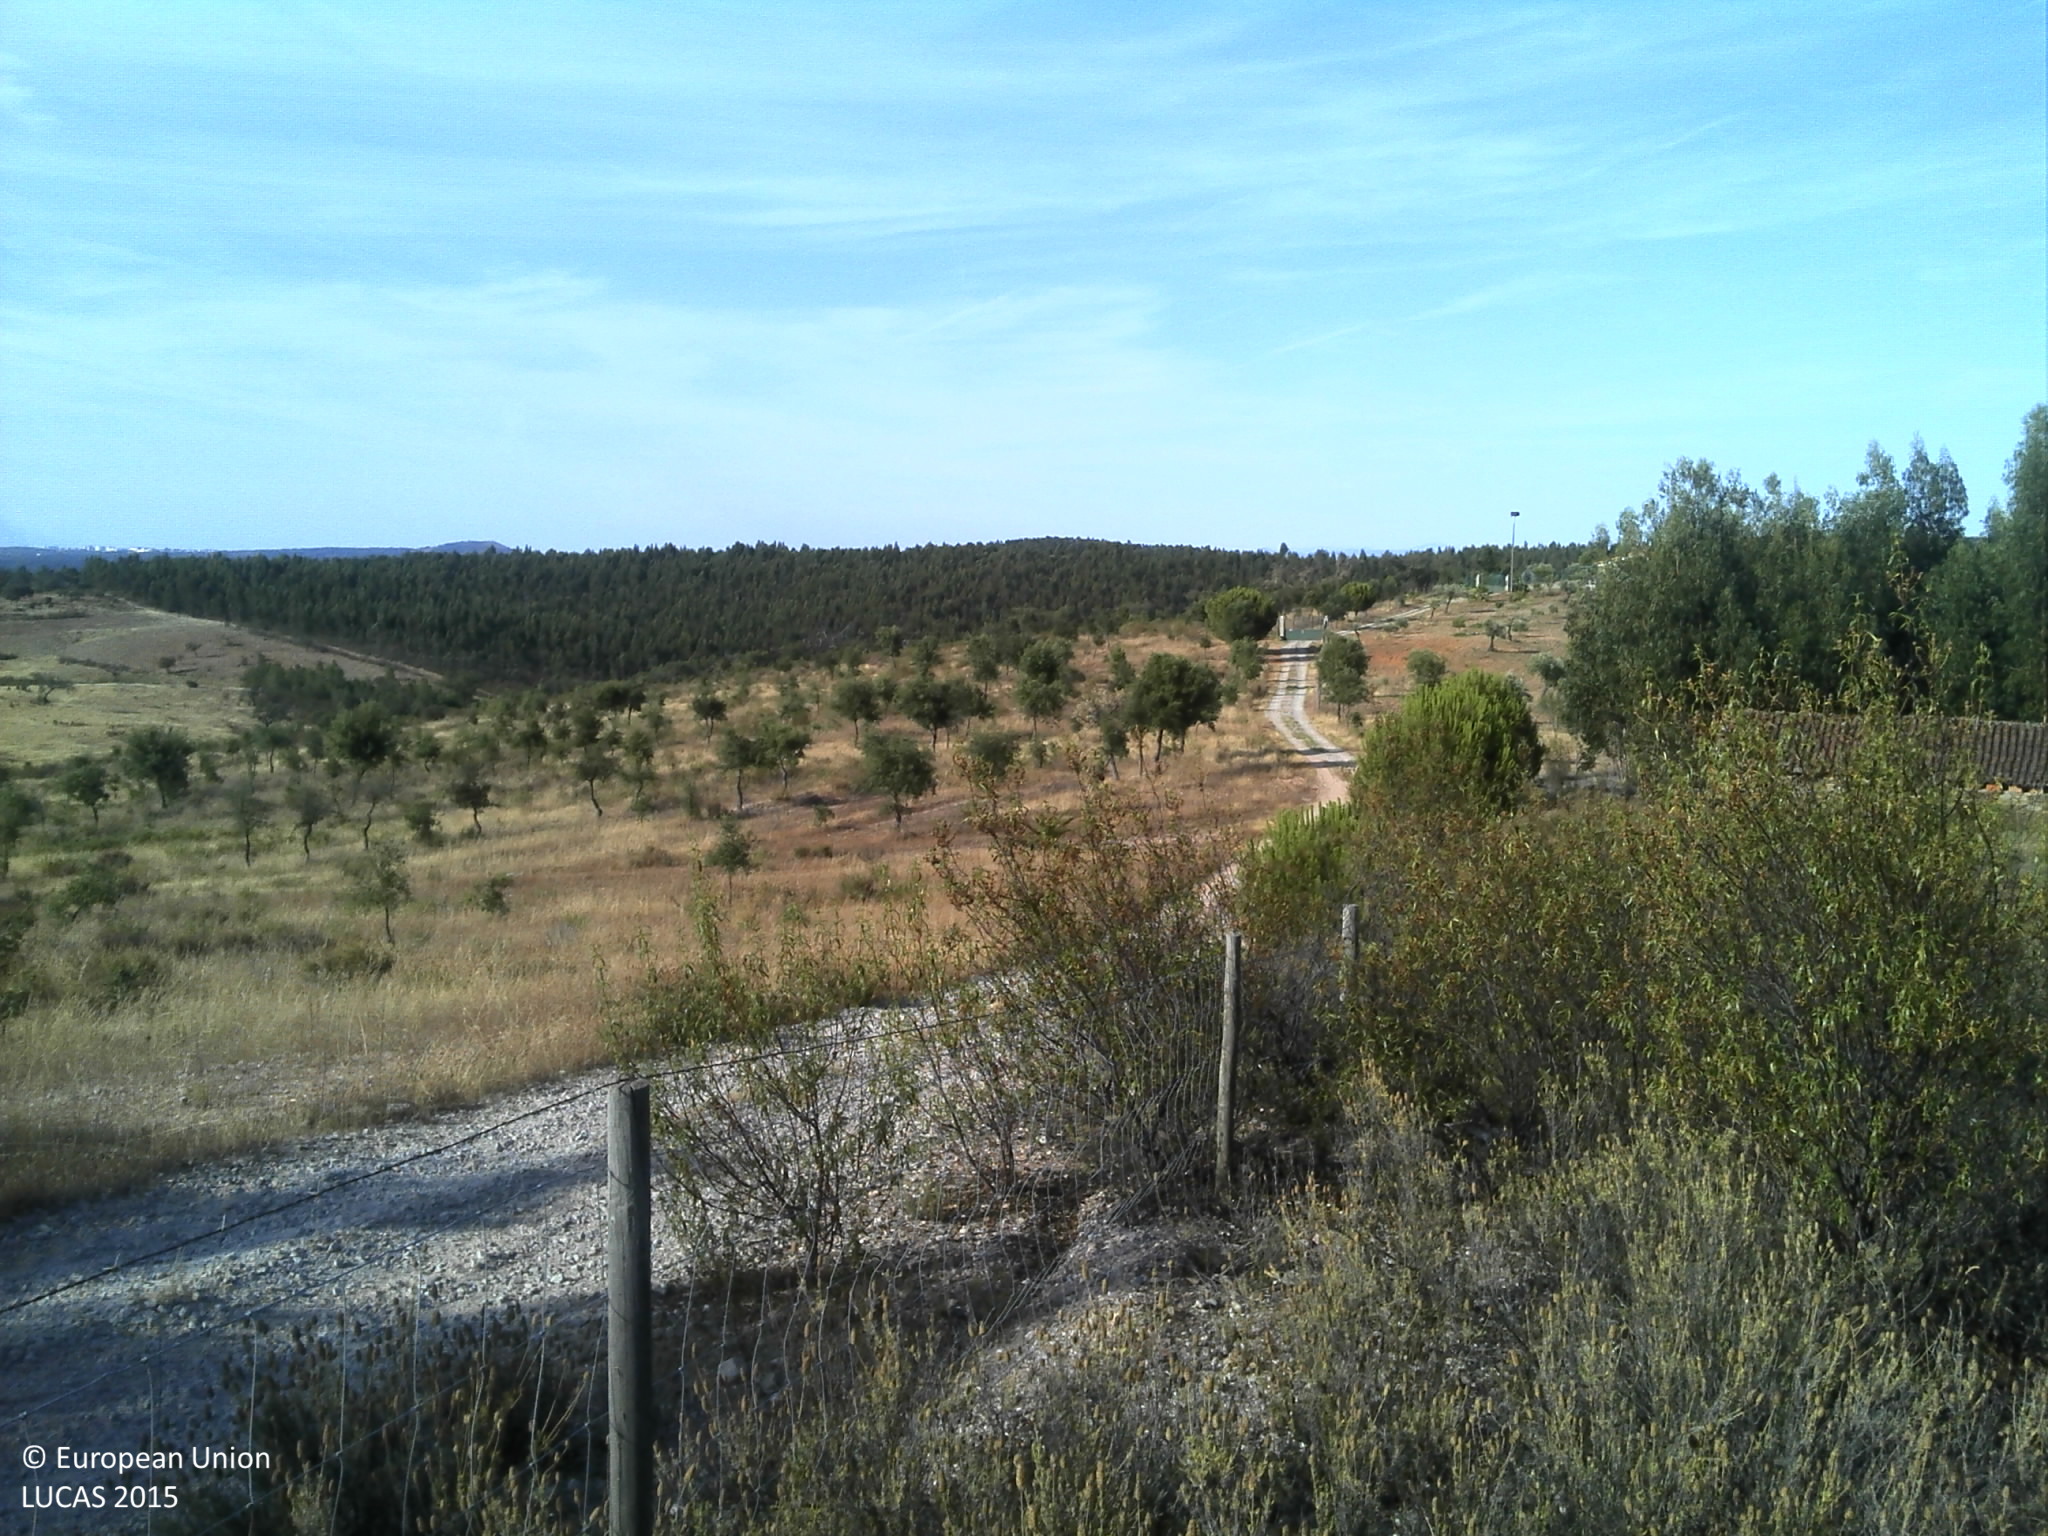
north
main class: Woodland
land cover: Broadleaved woodland
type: broadleaved evergreen forest
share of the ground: 10 - 25 %
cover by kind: unconsolidated bare surface 60 %, broadleaved forest trees 20 %, shrubs 10 %, herbaceous plants 10 %
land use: Forestry
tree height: < 5 m
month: July
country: PT
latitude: 39.6945
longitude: -7.5077
